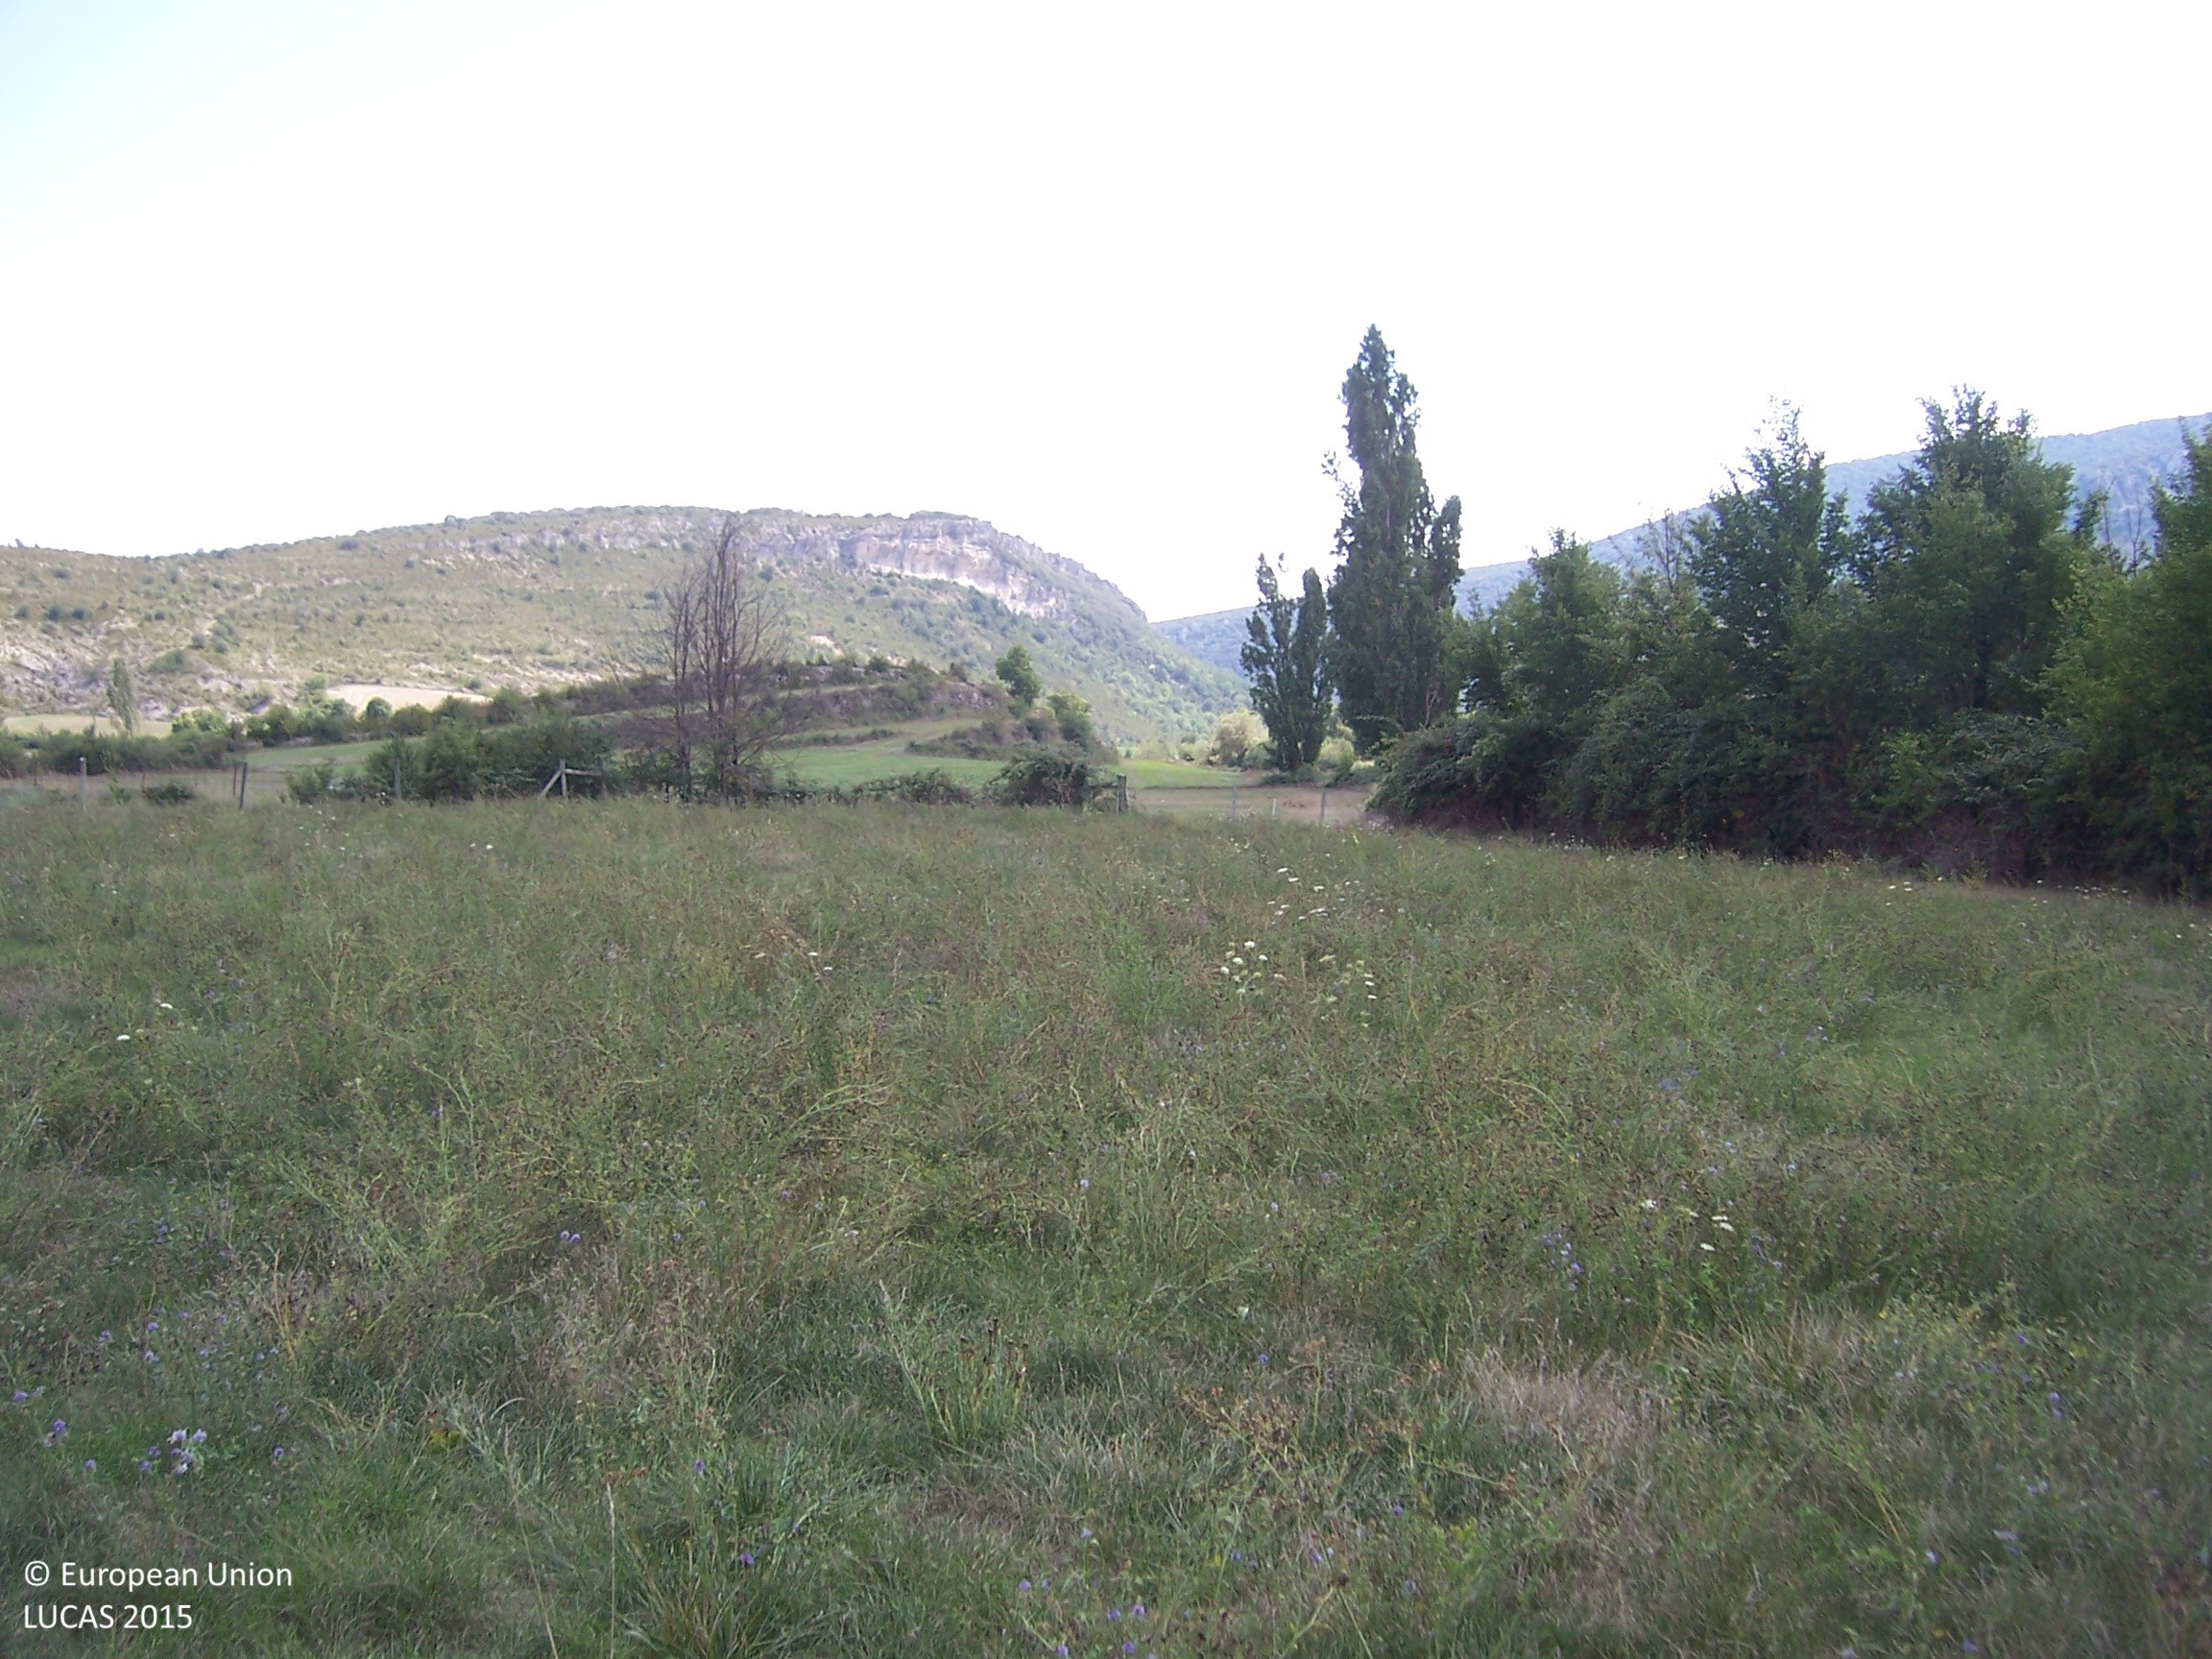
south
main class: Grassland
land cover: Grassland without tree/shrub cover
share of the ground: > 75 %
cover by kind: herbaceous plants 100 %
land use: Agriculture (excluding fallow land and kitchen gardens)
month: August
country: ES
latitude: 42.3077
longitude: 0.0434
